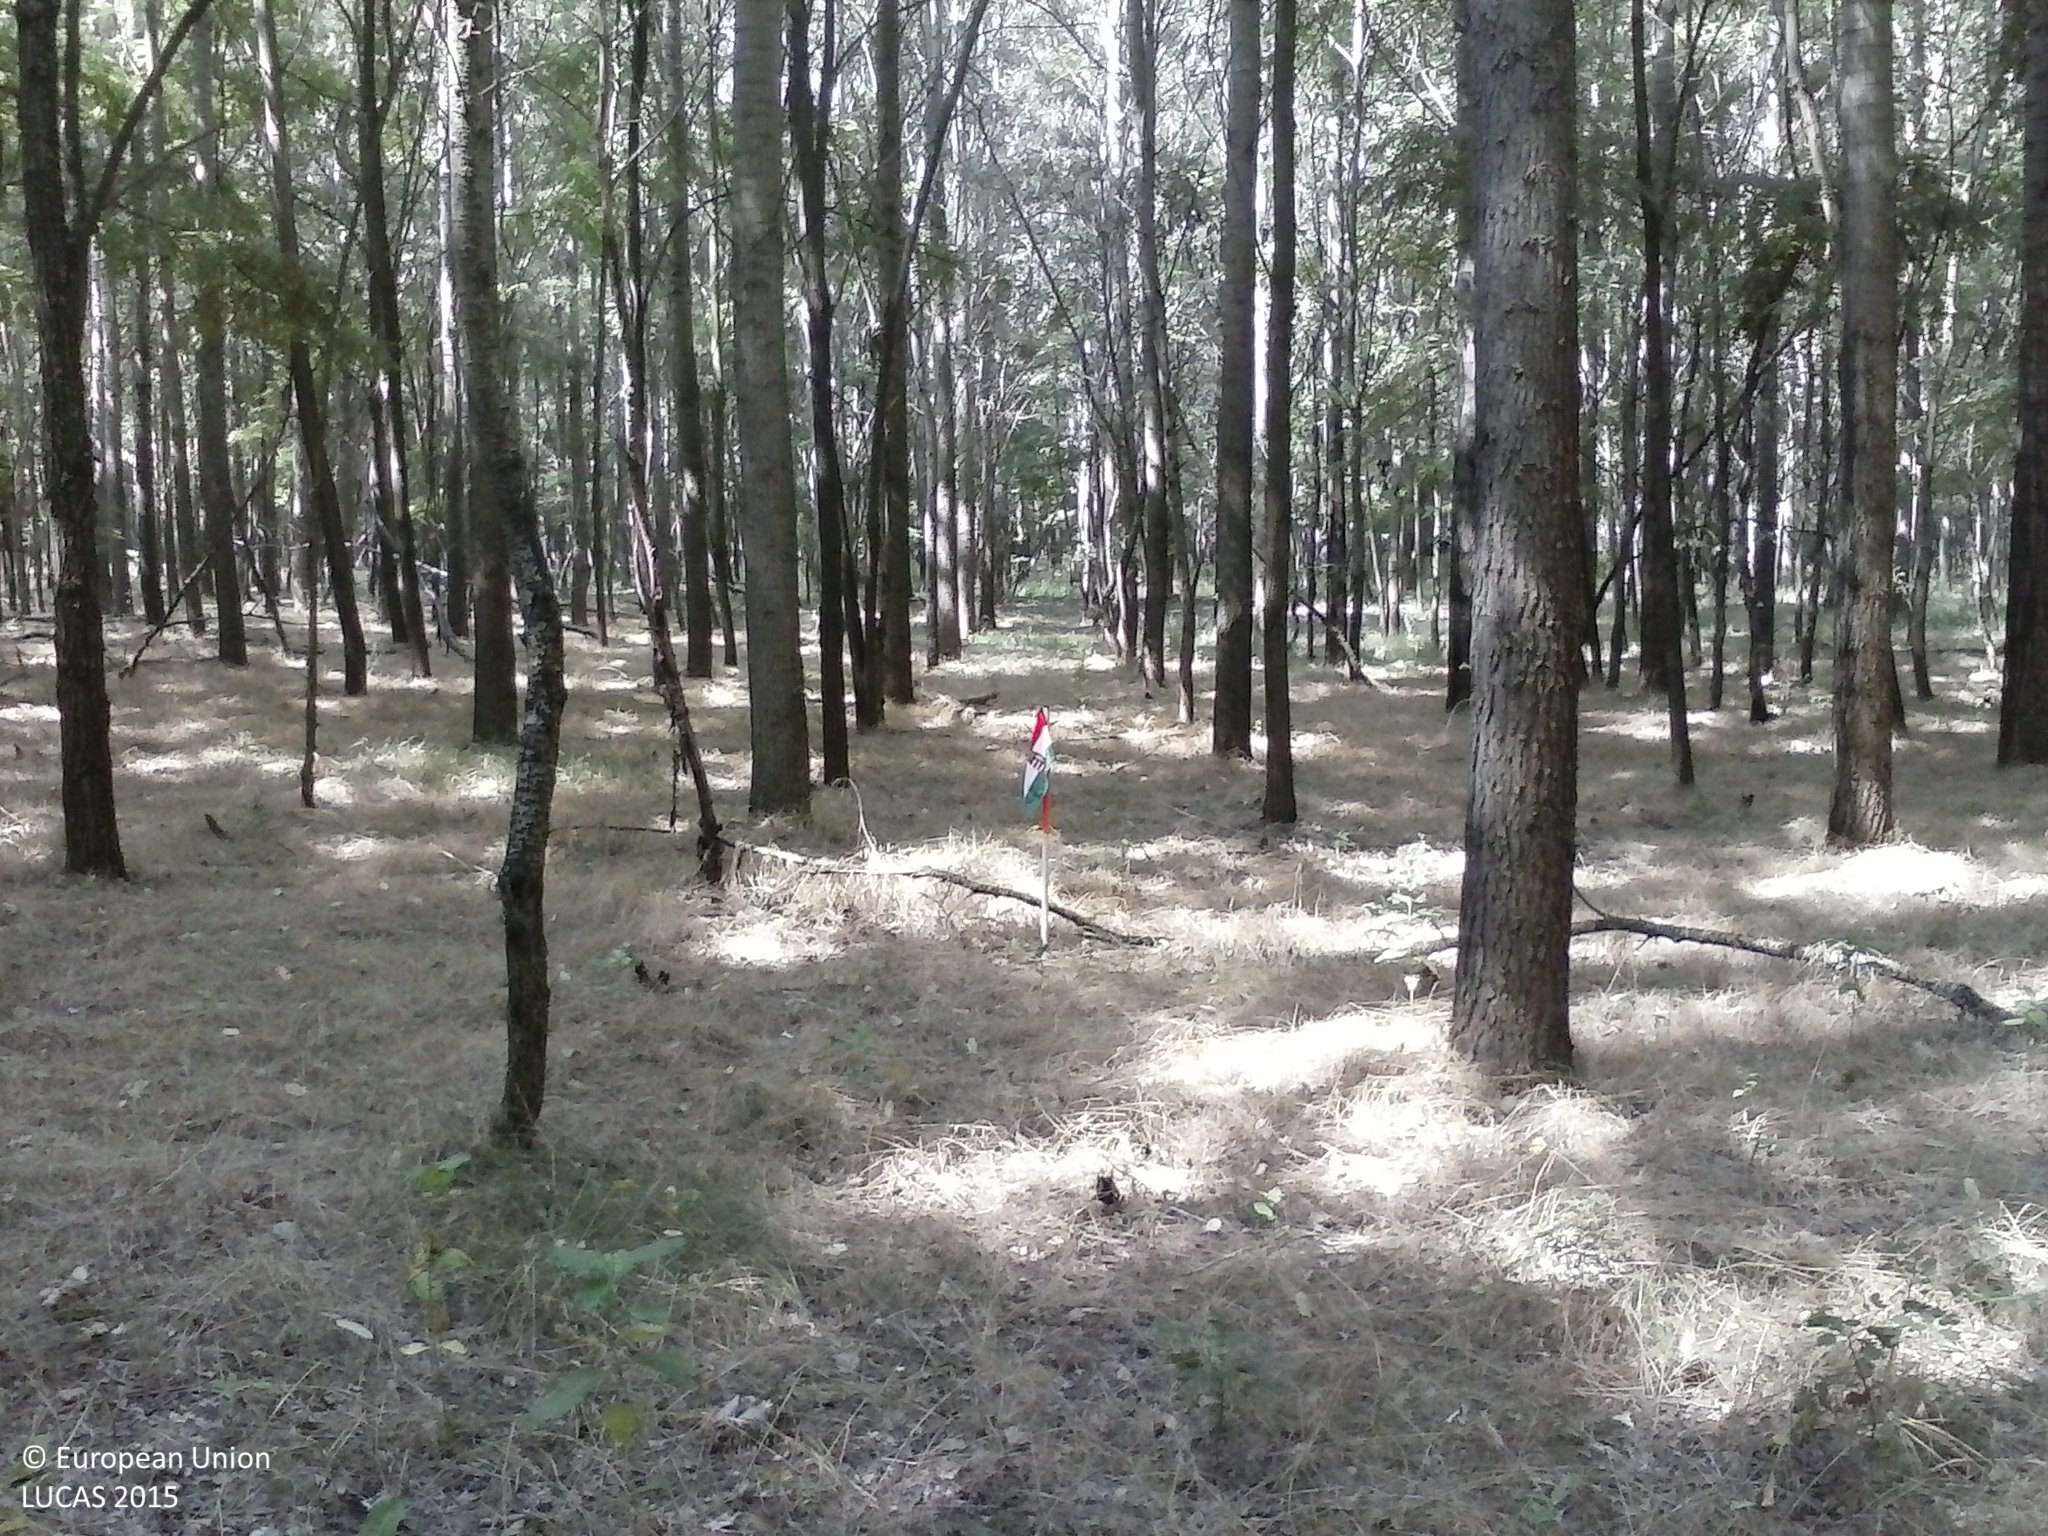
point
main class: Woodland
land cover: Broadleaved woodland
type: mesophytic deciduous forest
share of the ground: > 75 %
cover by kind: broadleaved forest trees 90 %, herbaceous plants 10 %
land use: Forestry
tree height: > 5 m
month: July
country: HU
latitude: 46.4945
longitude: 19.6470
